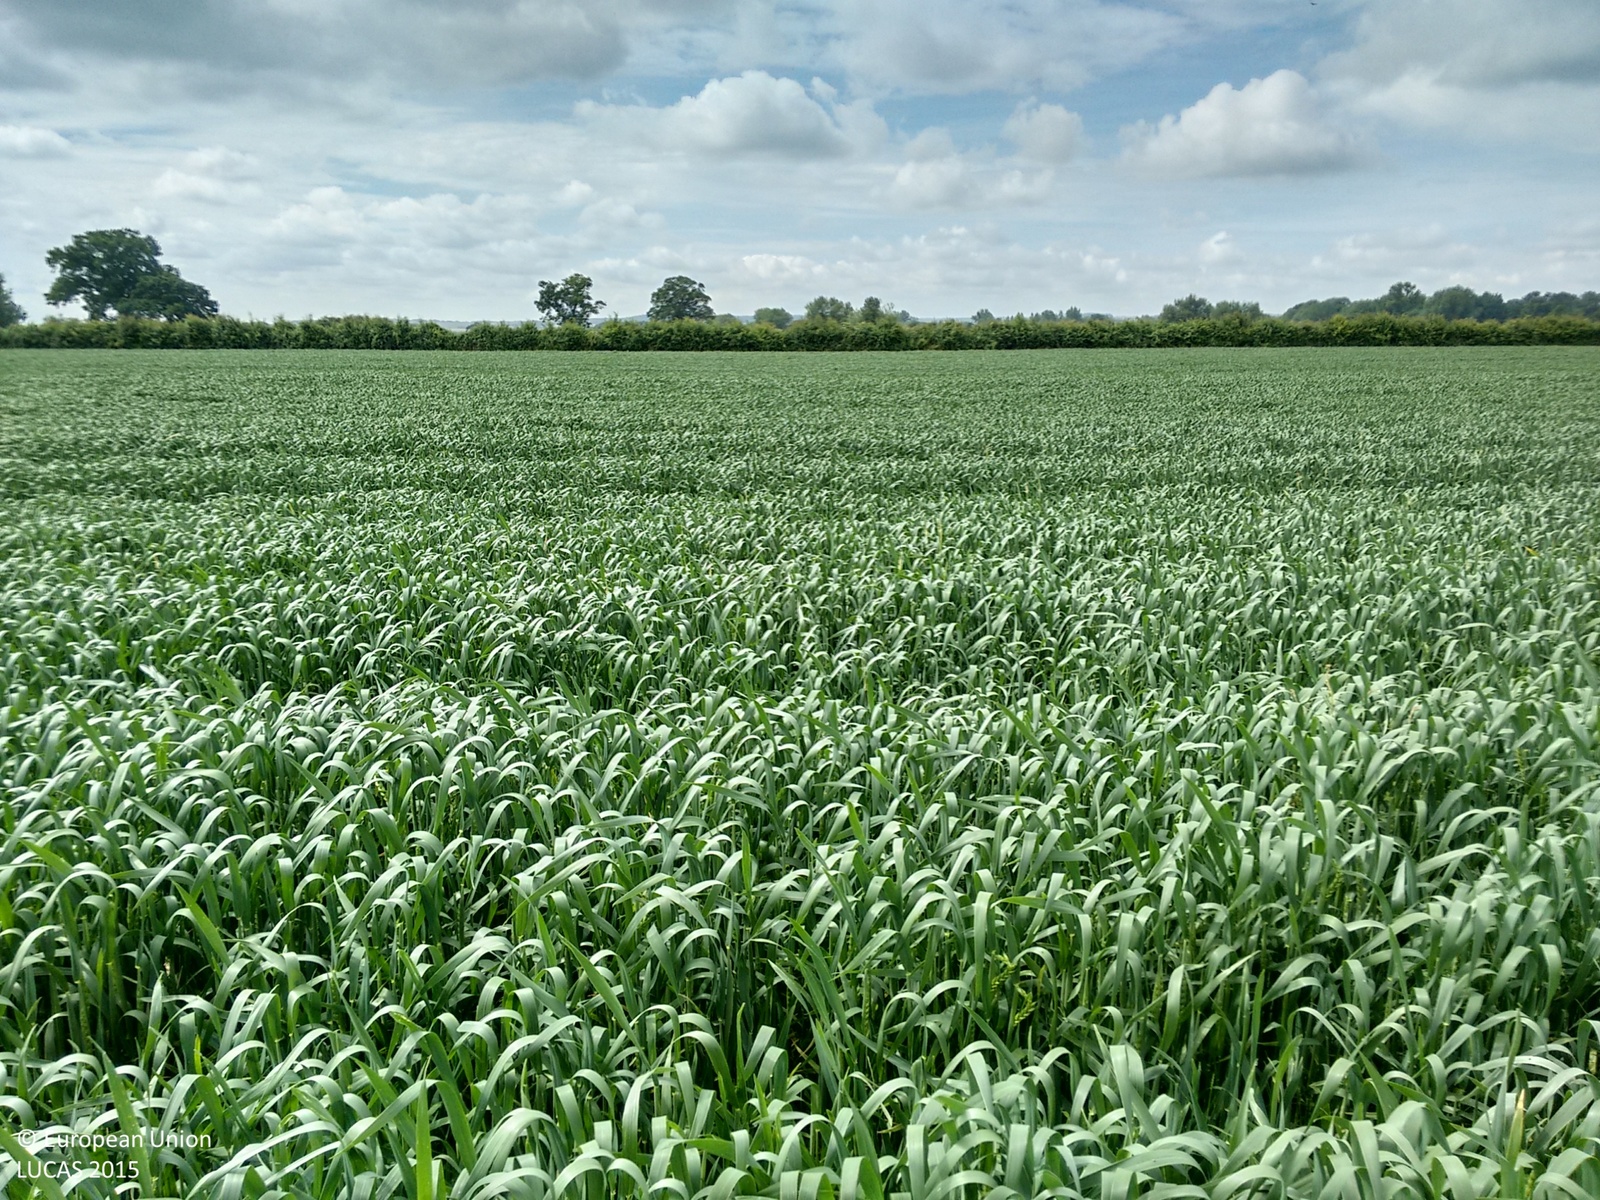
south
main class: Cropland
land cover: Common wheat
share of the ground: > 75 %
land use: Agriculture (excluding fallow land and kitchen gardens)
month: June
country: GB
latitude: 51.6114
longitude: -1.1807
